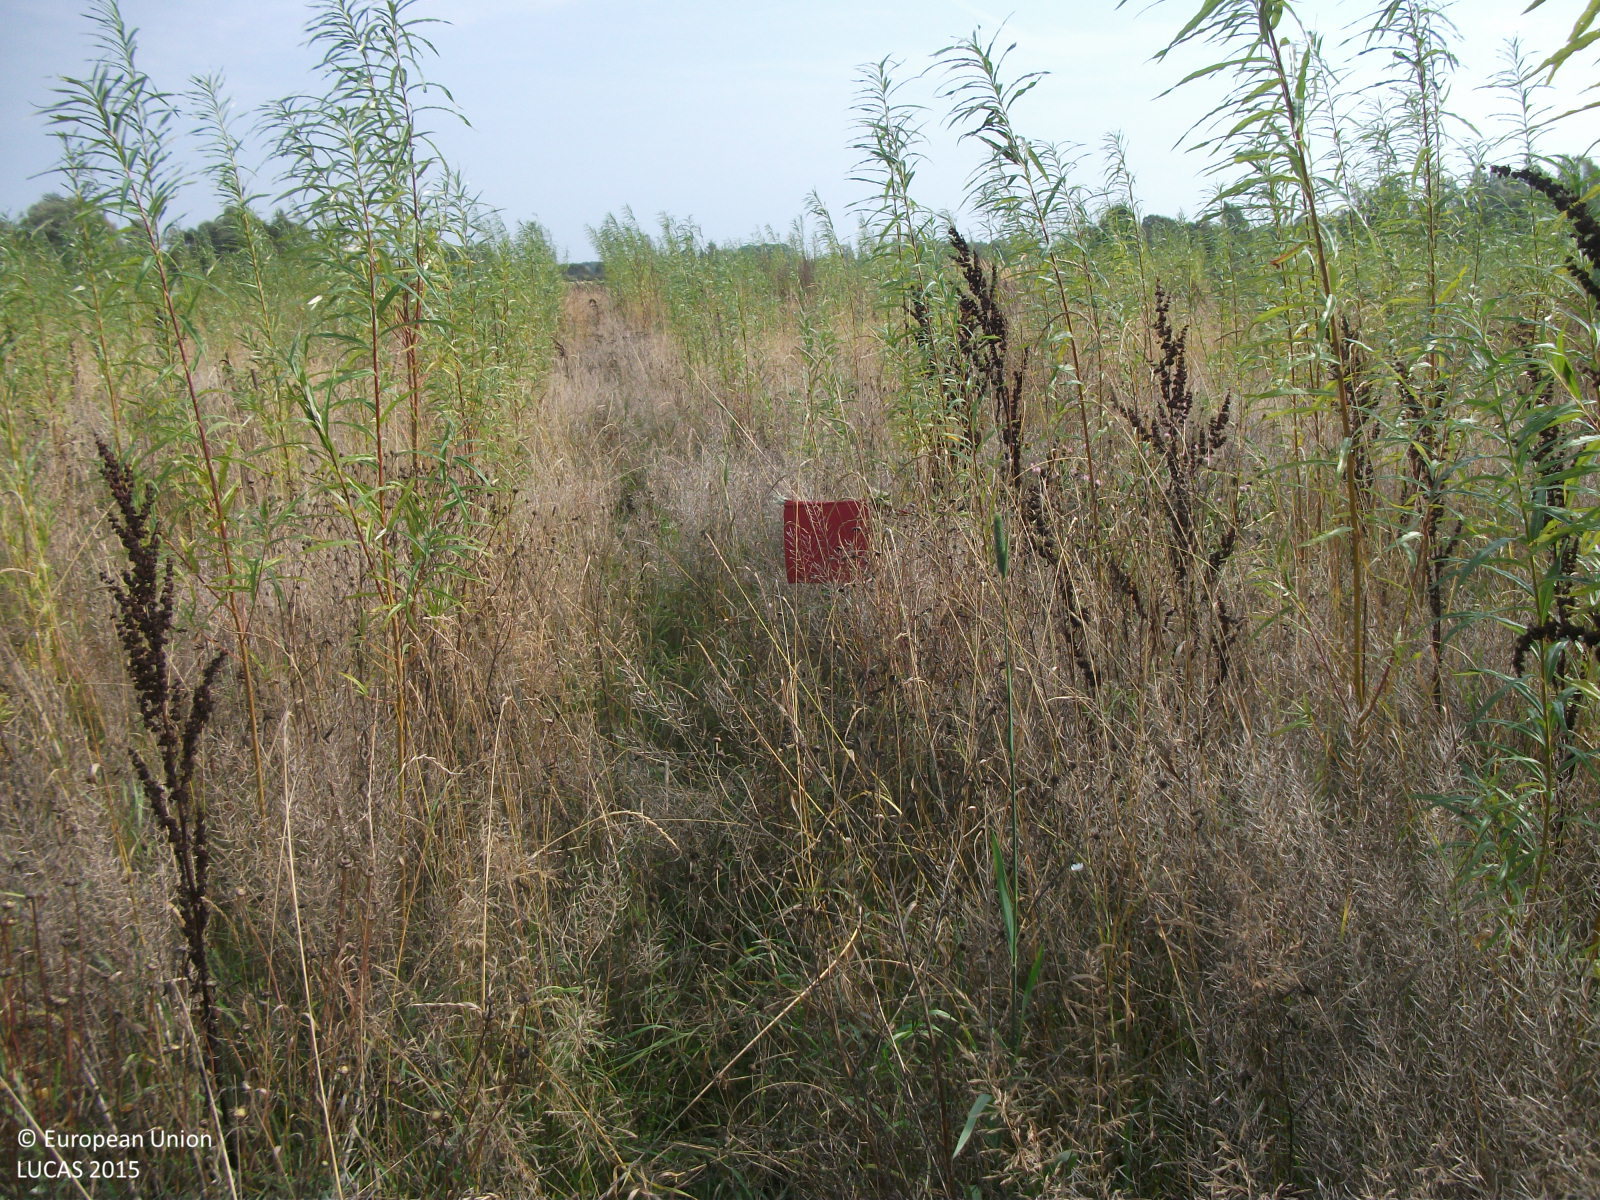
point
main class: Cropland
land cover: Permanent industrial crops
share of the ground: 25 - 50 %
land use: Agriculture (excluding fallow land and kitchen gardens)
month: September
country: LV
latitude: 57.7754
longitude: 24.4991
